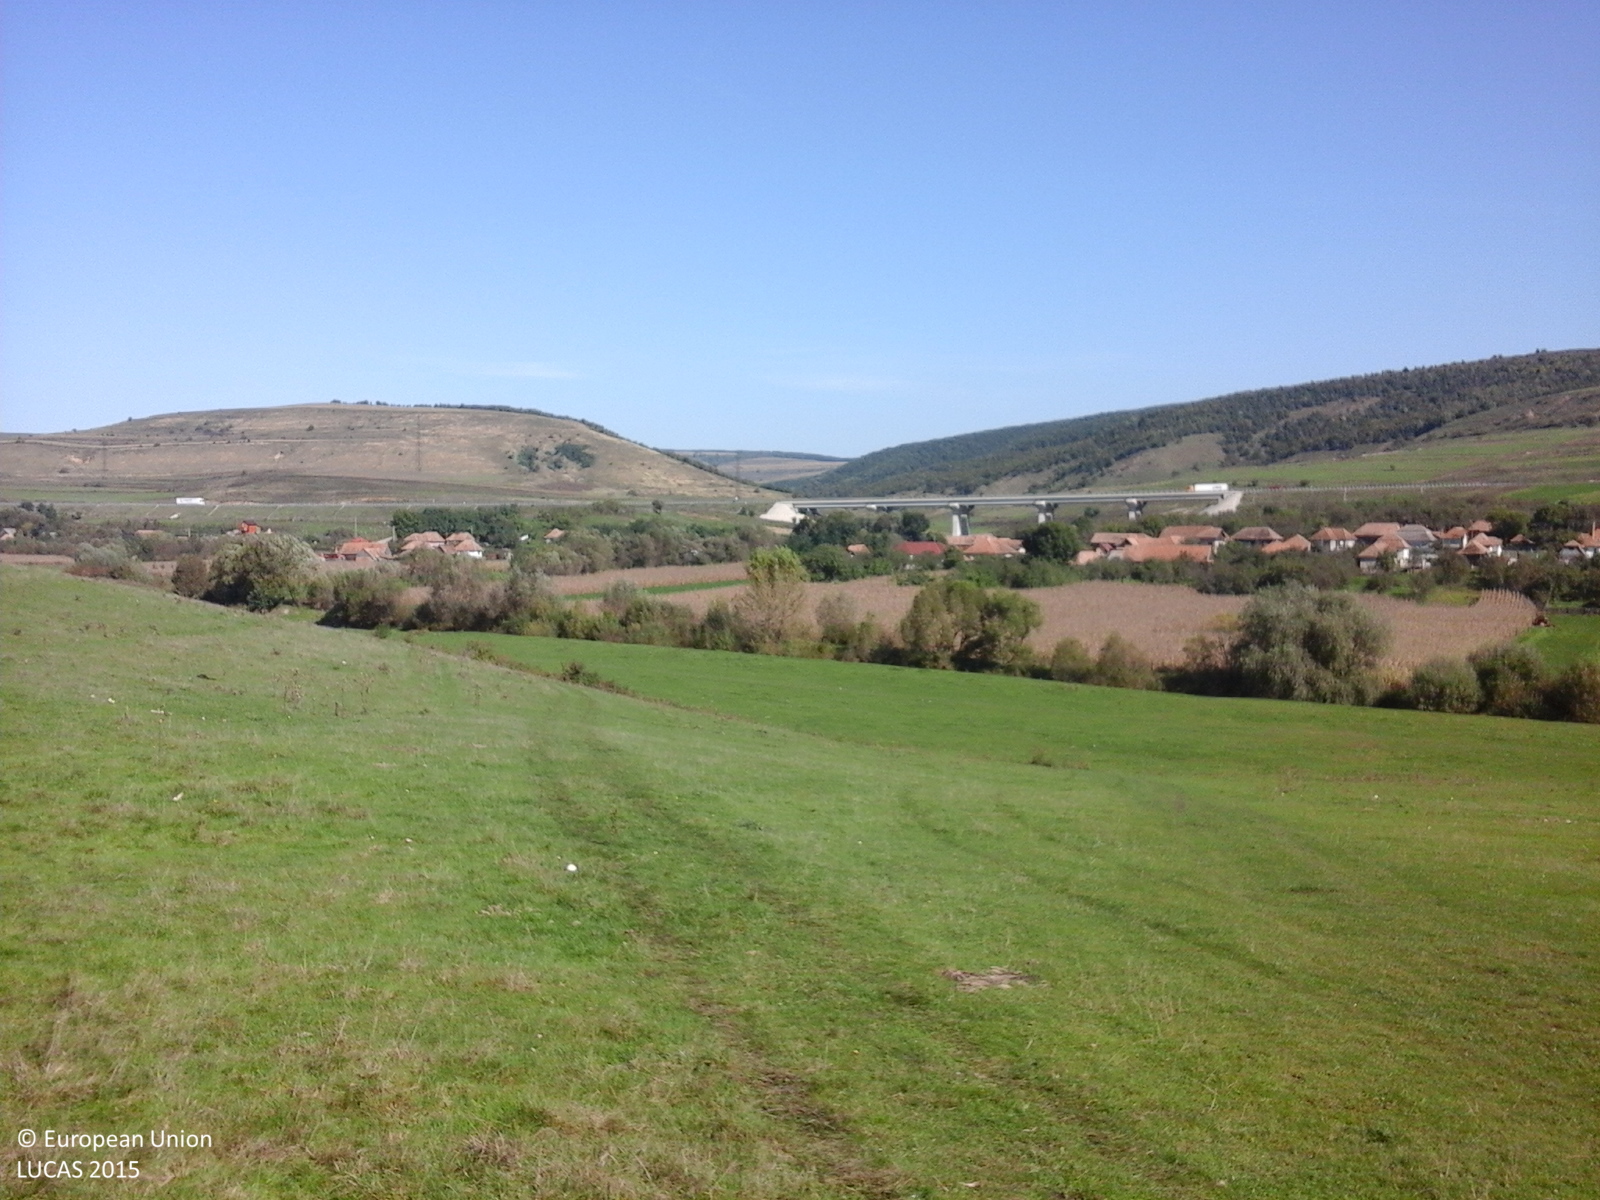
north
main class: Grassland
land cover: Grassland without tree/shrub cover
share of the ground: > 75 %
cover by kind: herbaceous plants 100 %
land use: Agriculture (excluding fallow land and kitchen gardens)
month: October
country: RO
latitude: 46.6115
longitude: 23.5838
